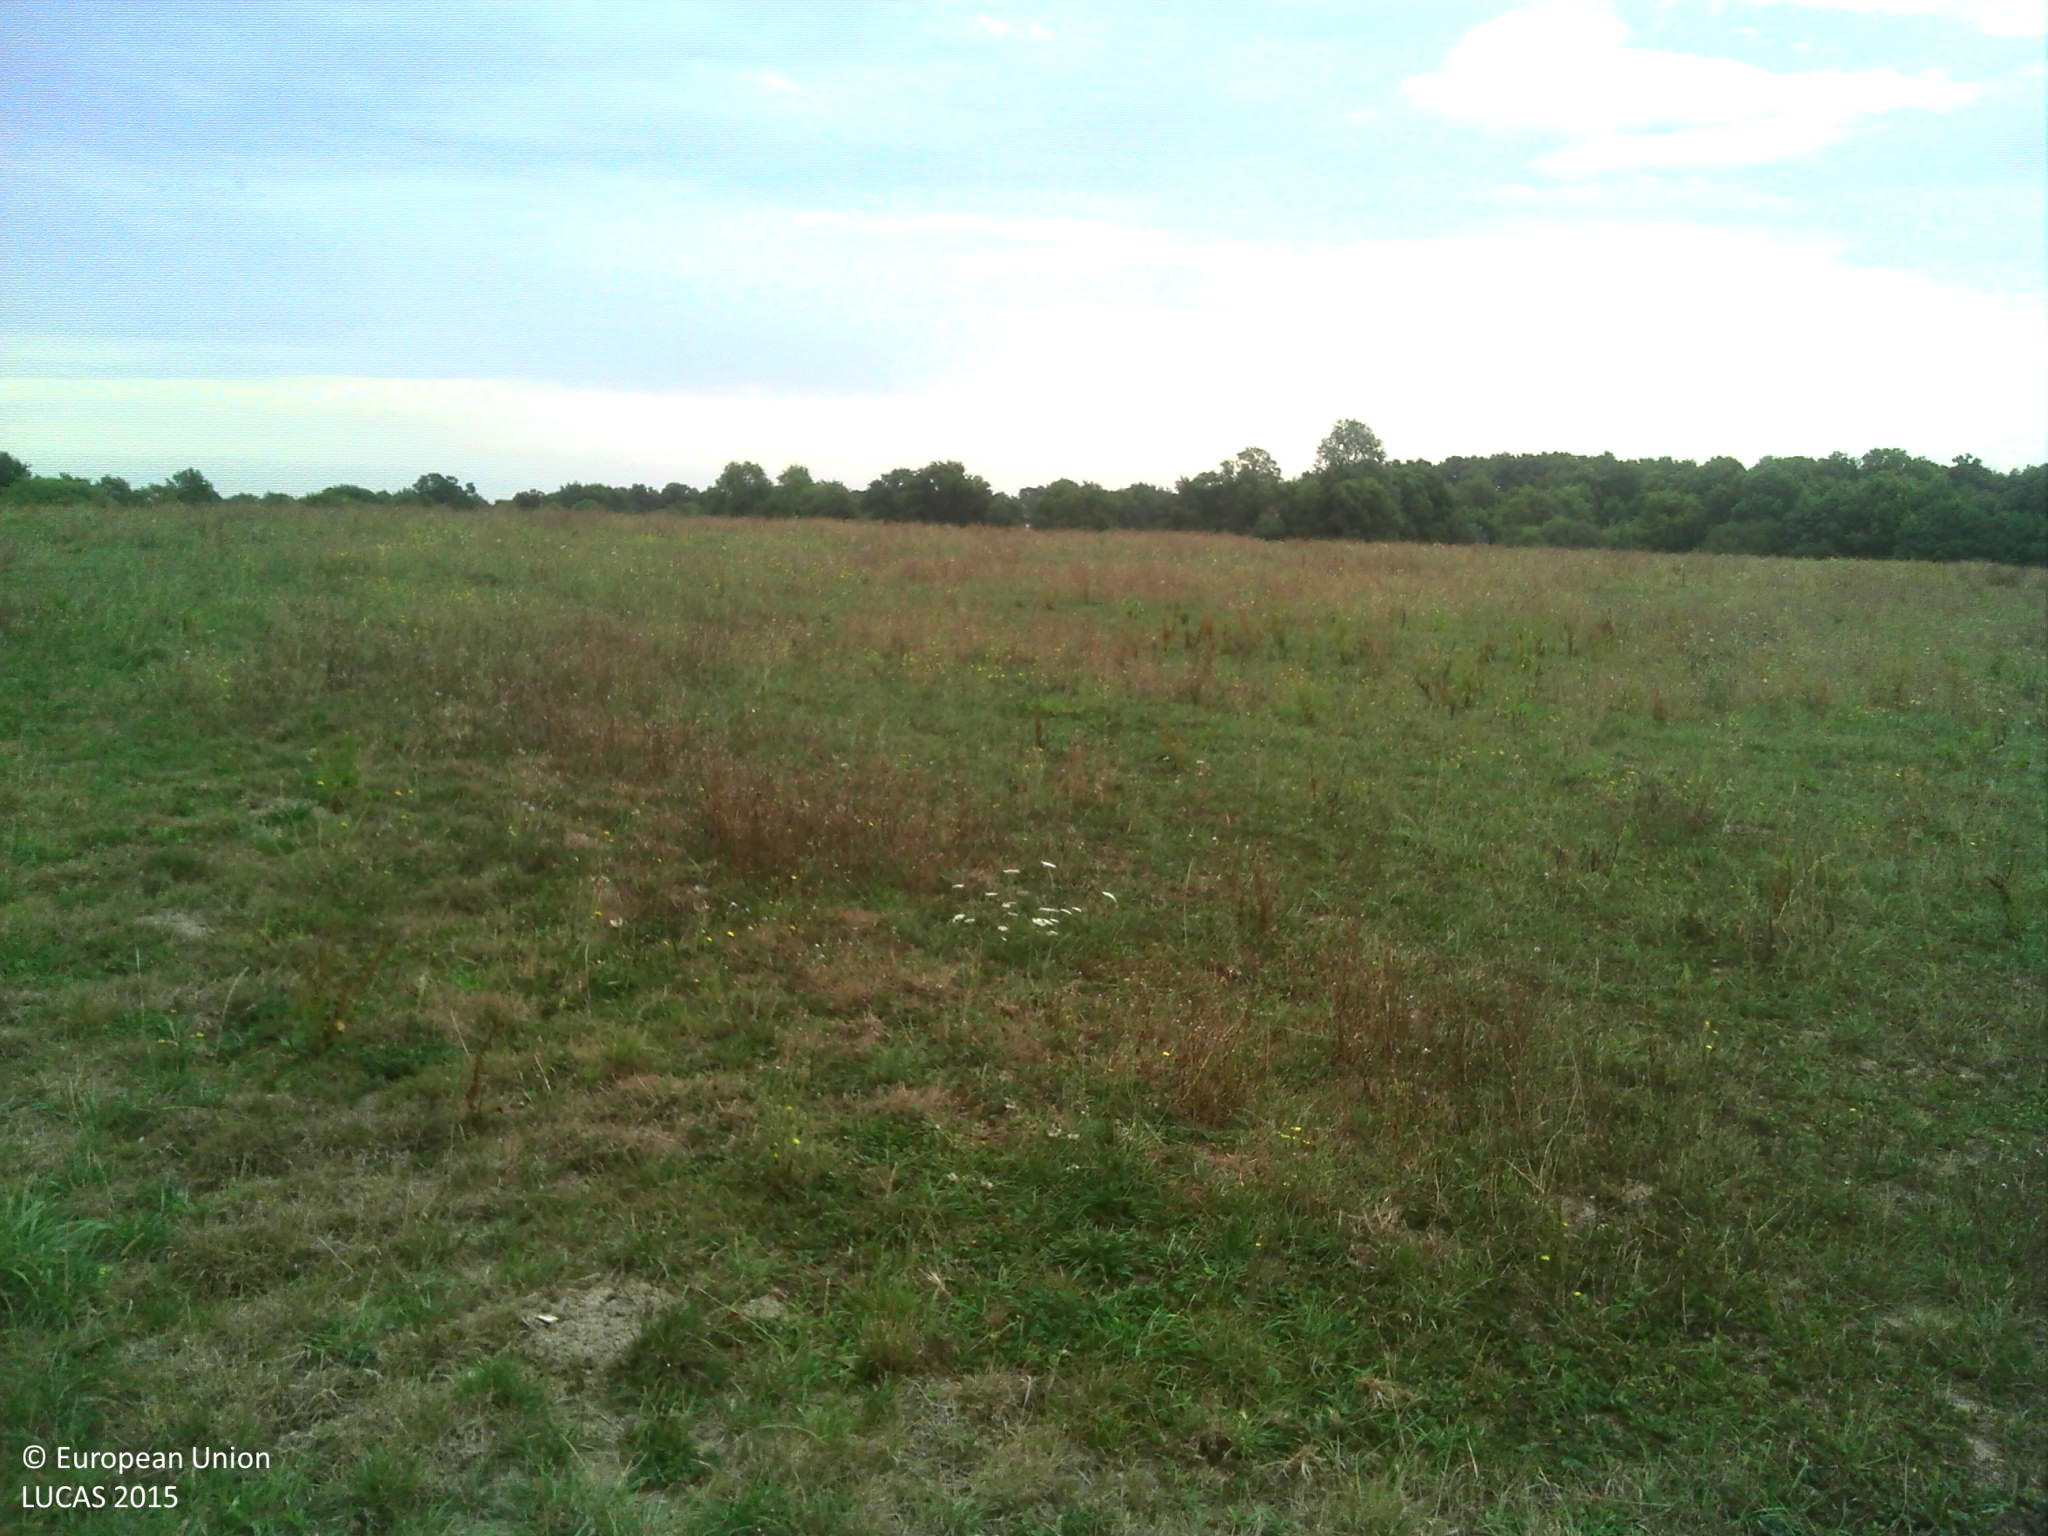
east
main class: Grassland
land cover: Grassland without tree/shrub cover
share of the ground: > 75 %
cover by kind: herbaceous plants 100 %
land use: Agriculture (excluding fallow land and kitchen gardens)
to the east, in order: Grassland without tree/shrub cover; Fences; Grassland without tree/shrub cover; Fences; Grassland without tree/shrub cover; Fences; Grassland without tree/shrub cover
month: August
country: FR
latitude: 46.7189
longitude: -1.5922
